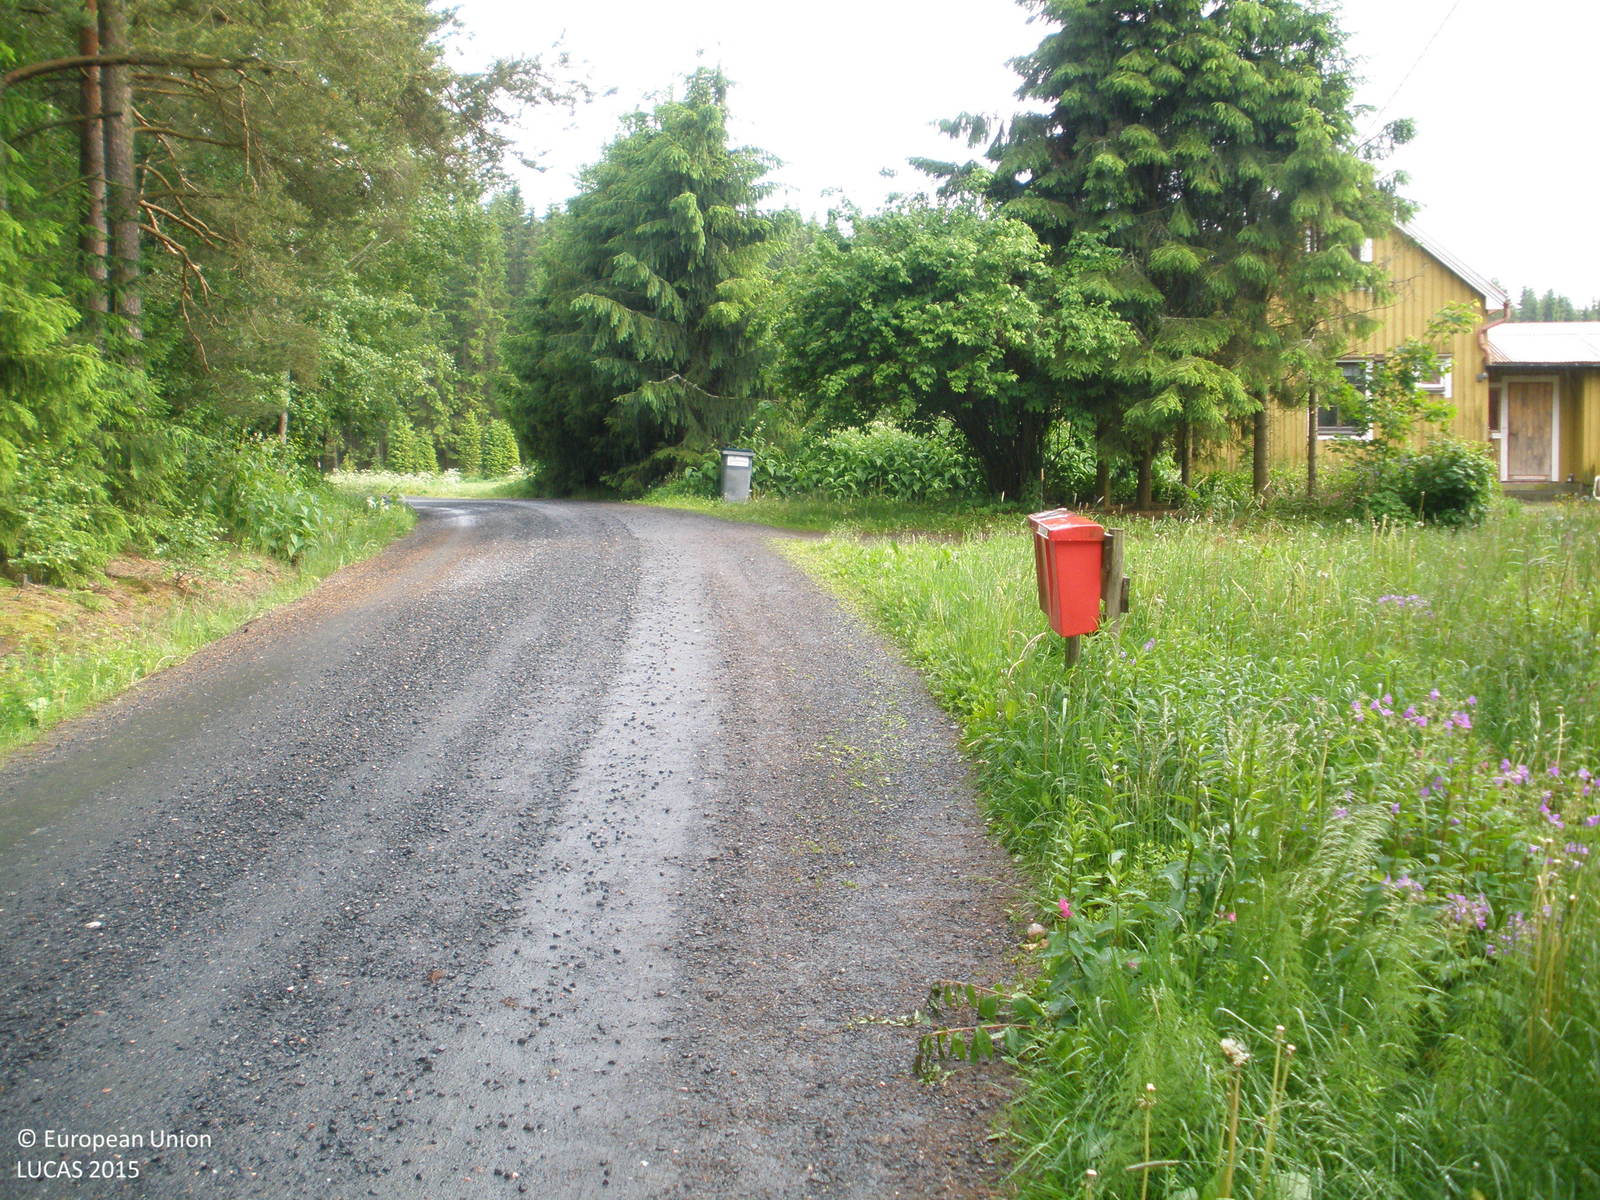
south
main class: Woodland
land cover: Broadleaved woodland
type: non-riverine alder, birch or aspen forest
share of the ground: > 75 %
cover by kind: broadleaved forest trees 80 %, herbaceous plants 15 %, shrubs 5 %
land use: Forestry
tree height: > 5 m
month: June
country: FI
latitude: 60.8847
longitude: 23.4779
